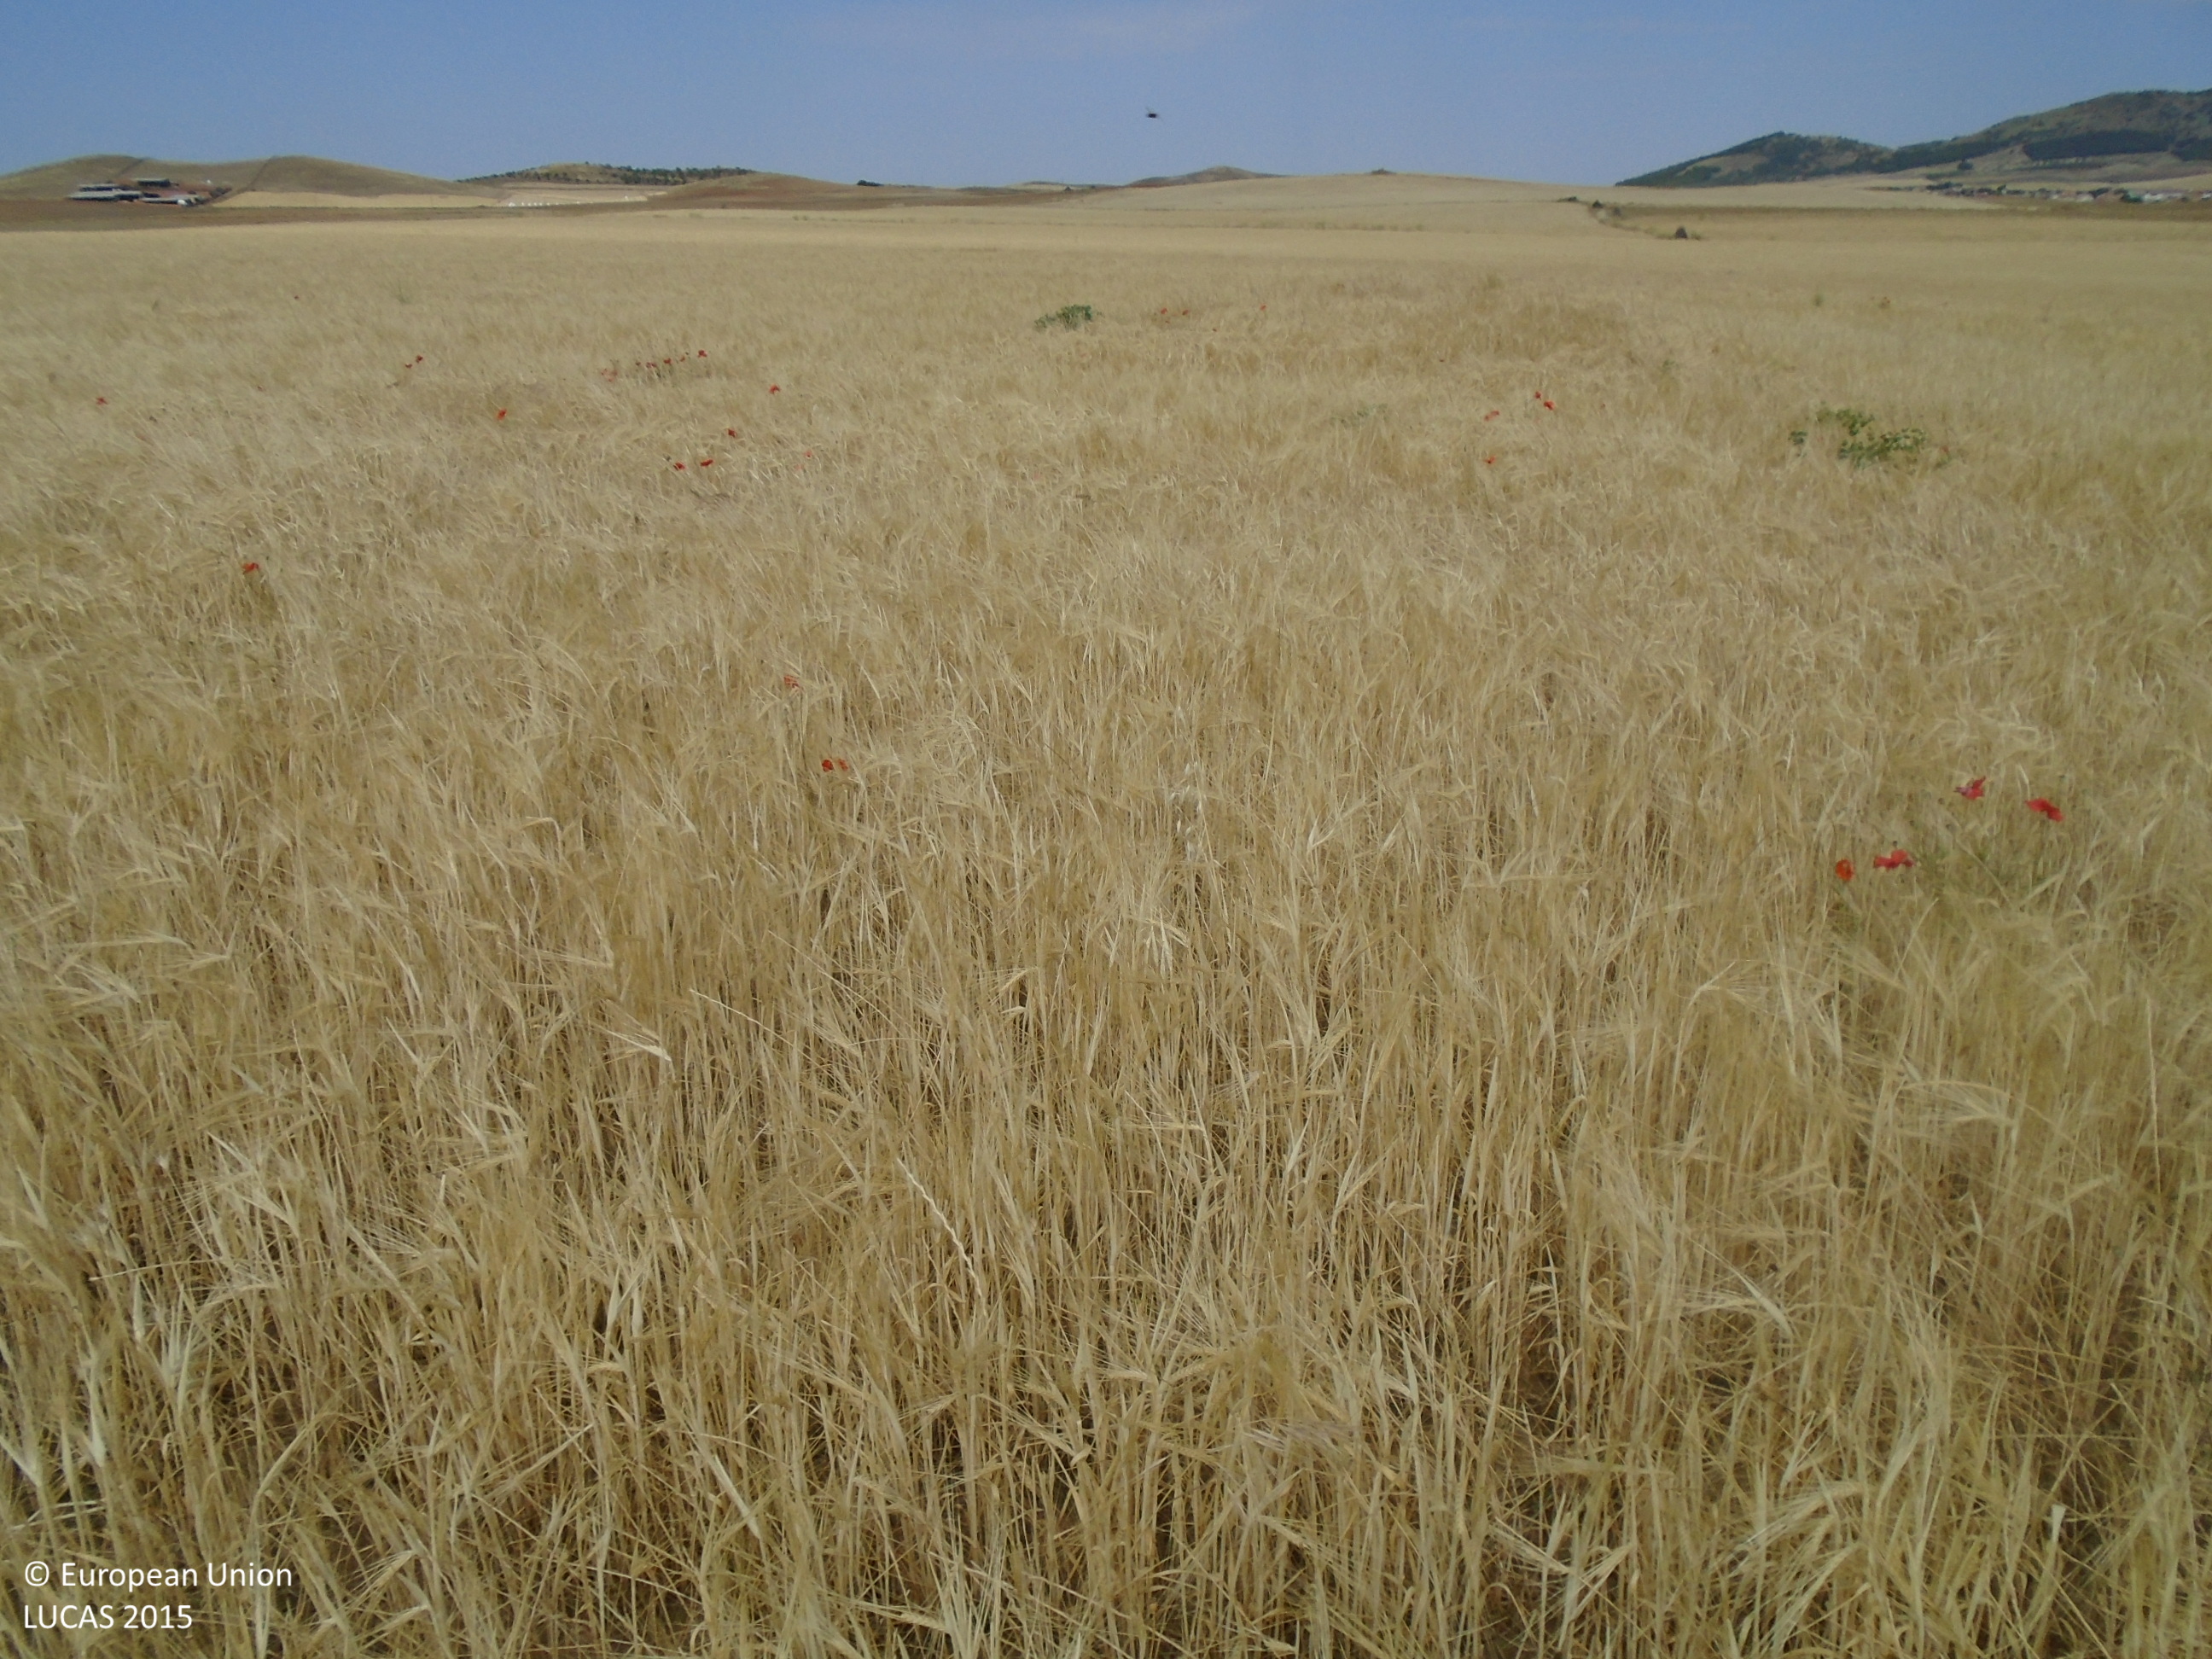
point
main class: Cropland
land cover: Barley
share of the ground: > 75 %
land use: Agriculture (excluding fallow land and kitchen gardens)
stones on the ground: < 10 %
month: June
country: ES
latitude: 39.7292
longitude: -4.1636
